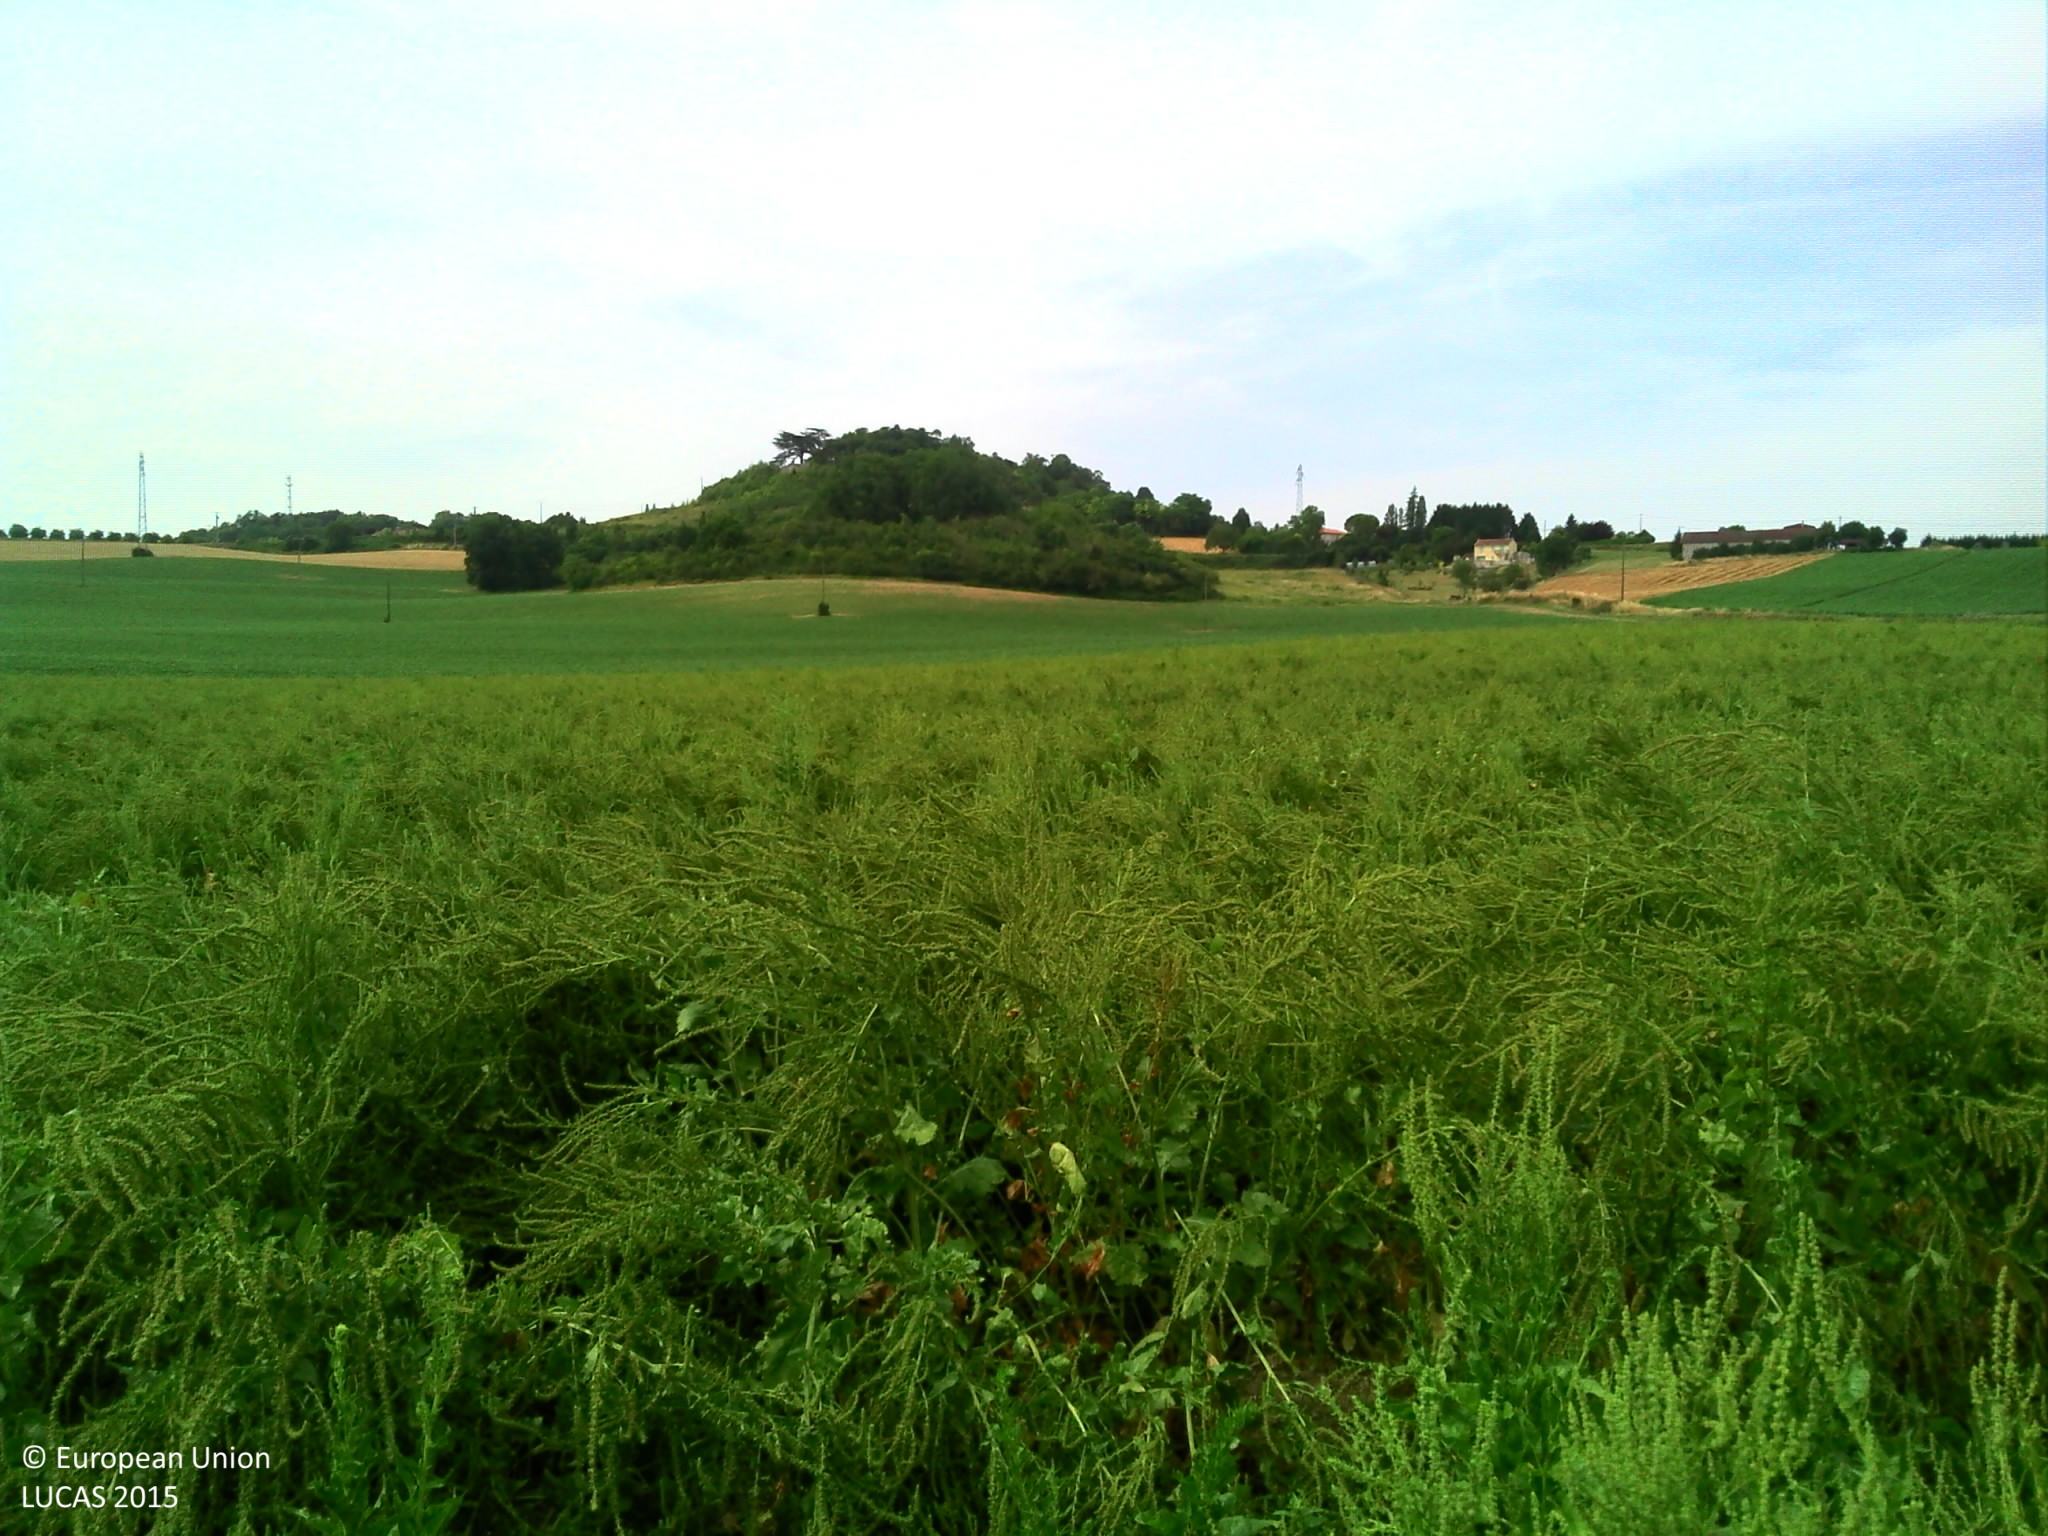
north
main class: Cropland
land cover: Sugar beet
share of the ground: > 75 %
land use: Agriculture (excluding fallow land and kitchen gardens)
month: July
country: FR
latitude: 44.4744
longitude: 0.8805
